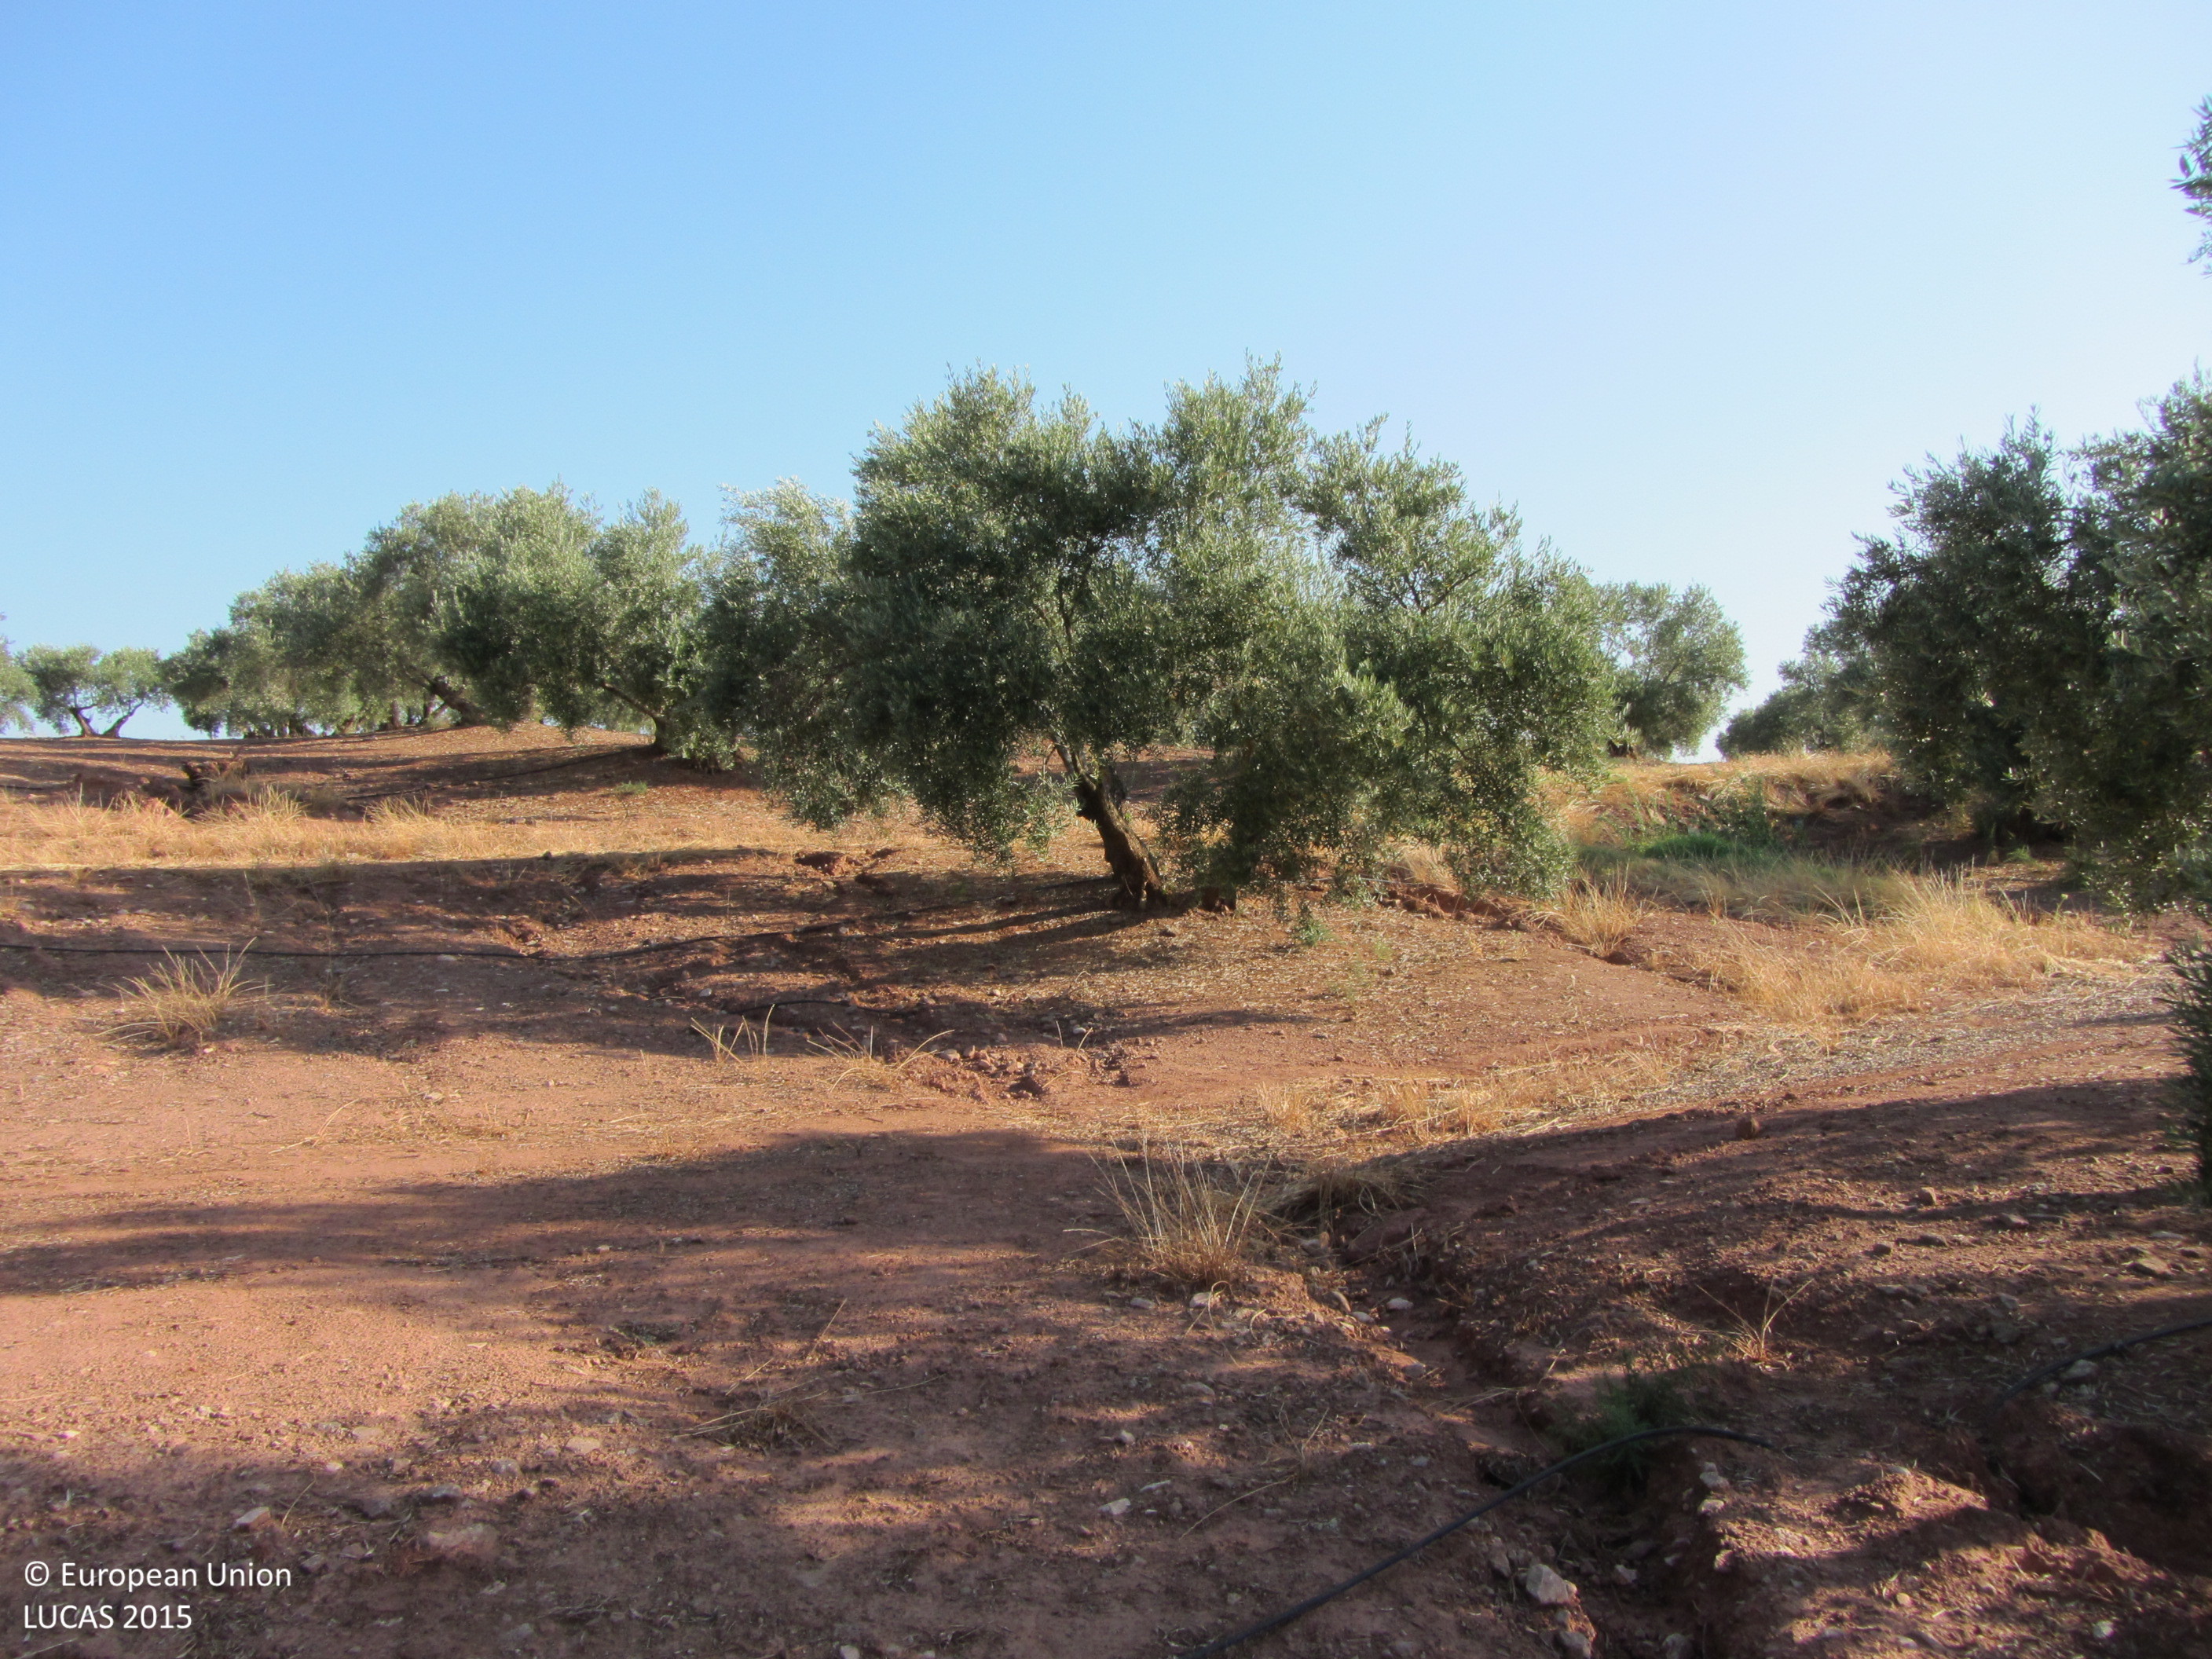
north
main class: Cropland
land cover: Olive groves
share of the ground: 25 - 50 %
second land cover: Other bare soil
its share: > 75 %
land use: Agriculture (excluding fallow land and kitchen gardens)
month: June
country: ES
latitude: 38.1864
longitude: -3.4180
